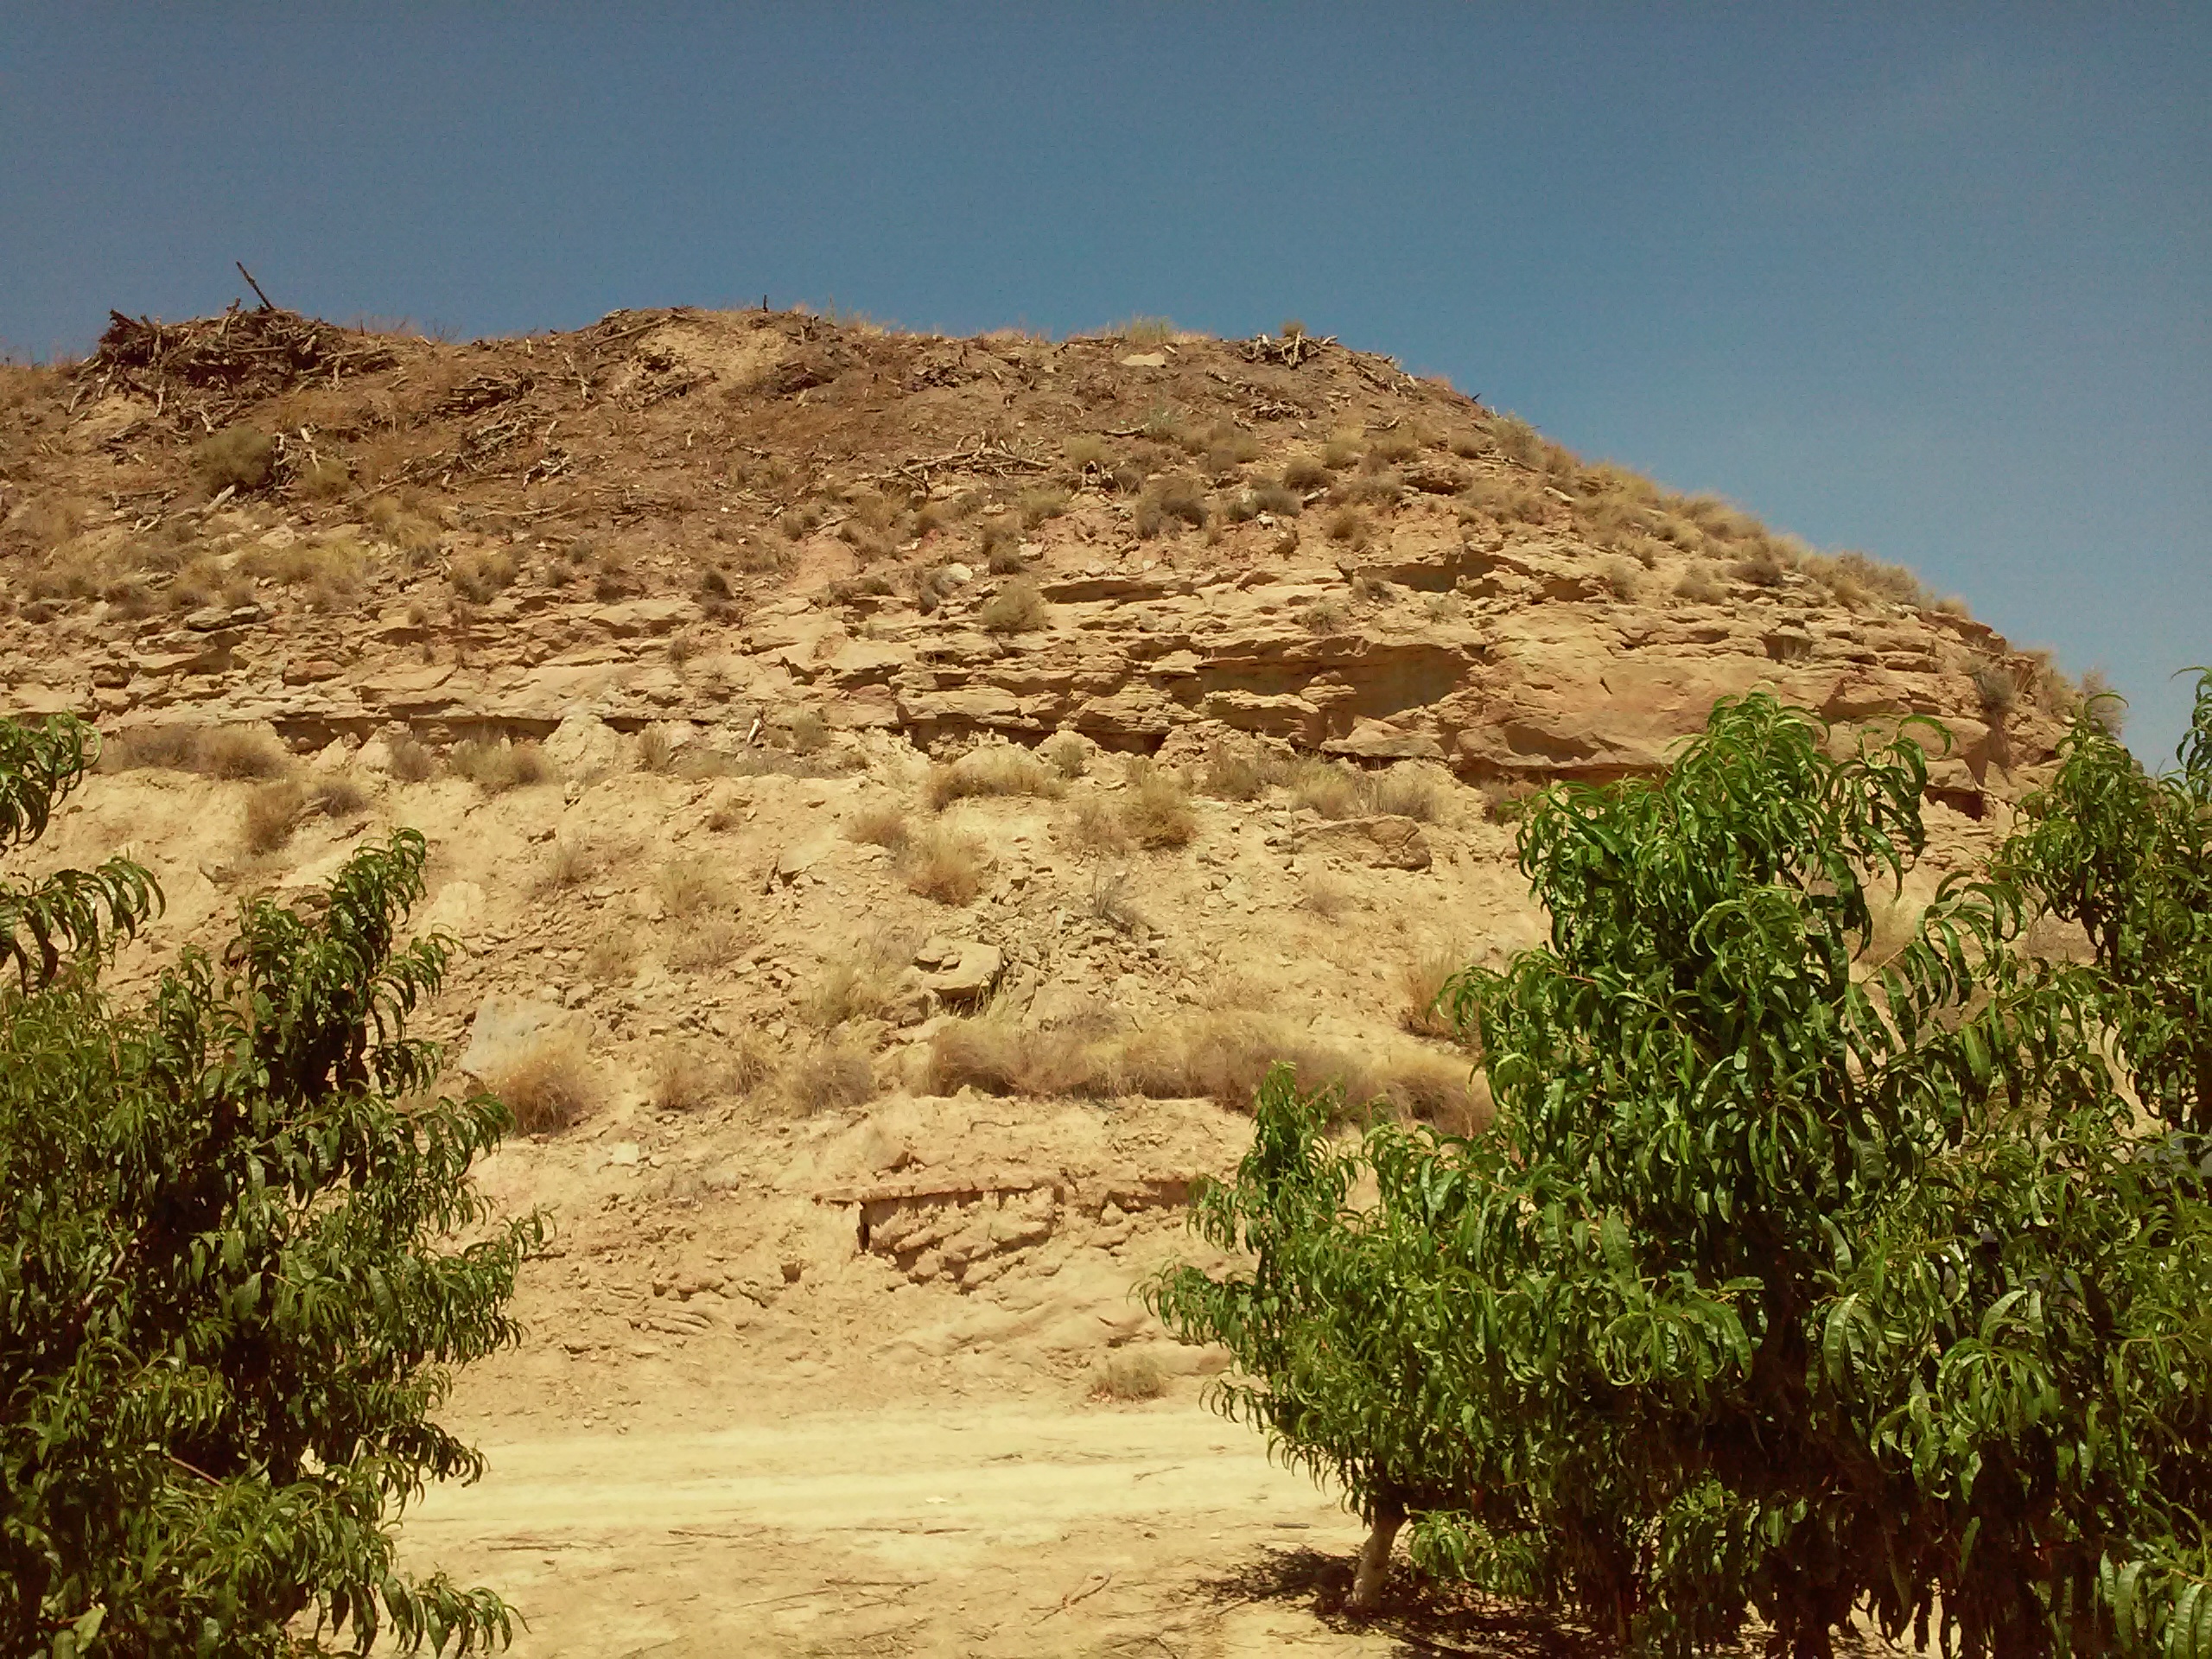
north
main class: Cropland
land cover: Other fruit trees and berries
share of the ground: 50 - 75 %
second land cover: Grassland without tree/shrub cover
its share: > 75 %
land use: Agriculture (excluding fallow land and kitchen gardens)
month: July
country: ES
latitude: 41.6467
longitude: 0.5378
